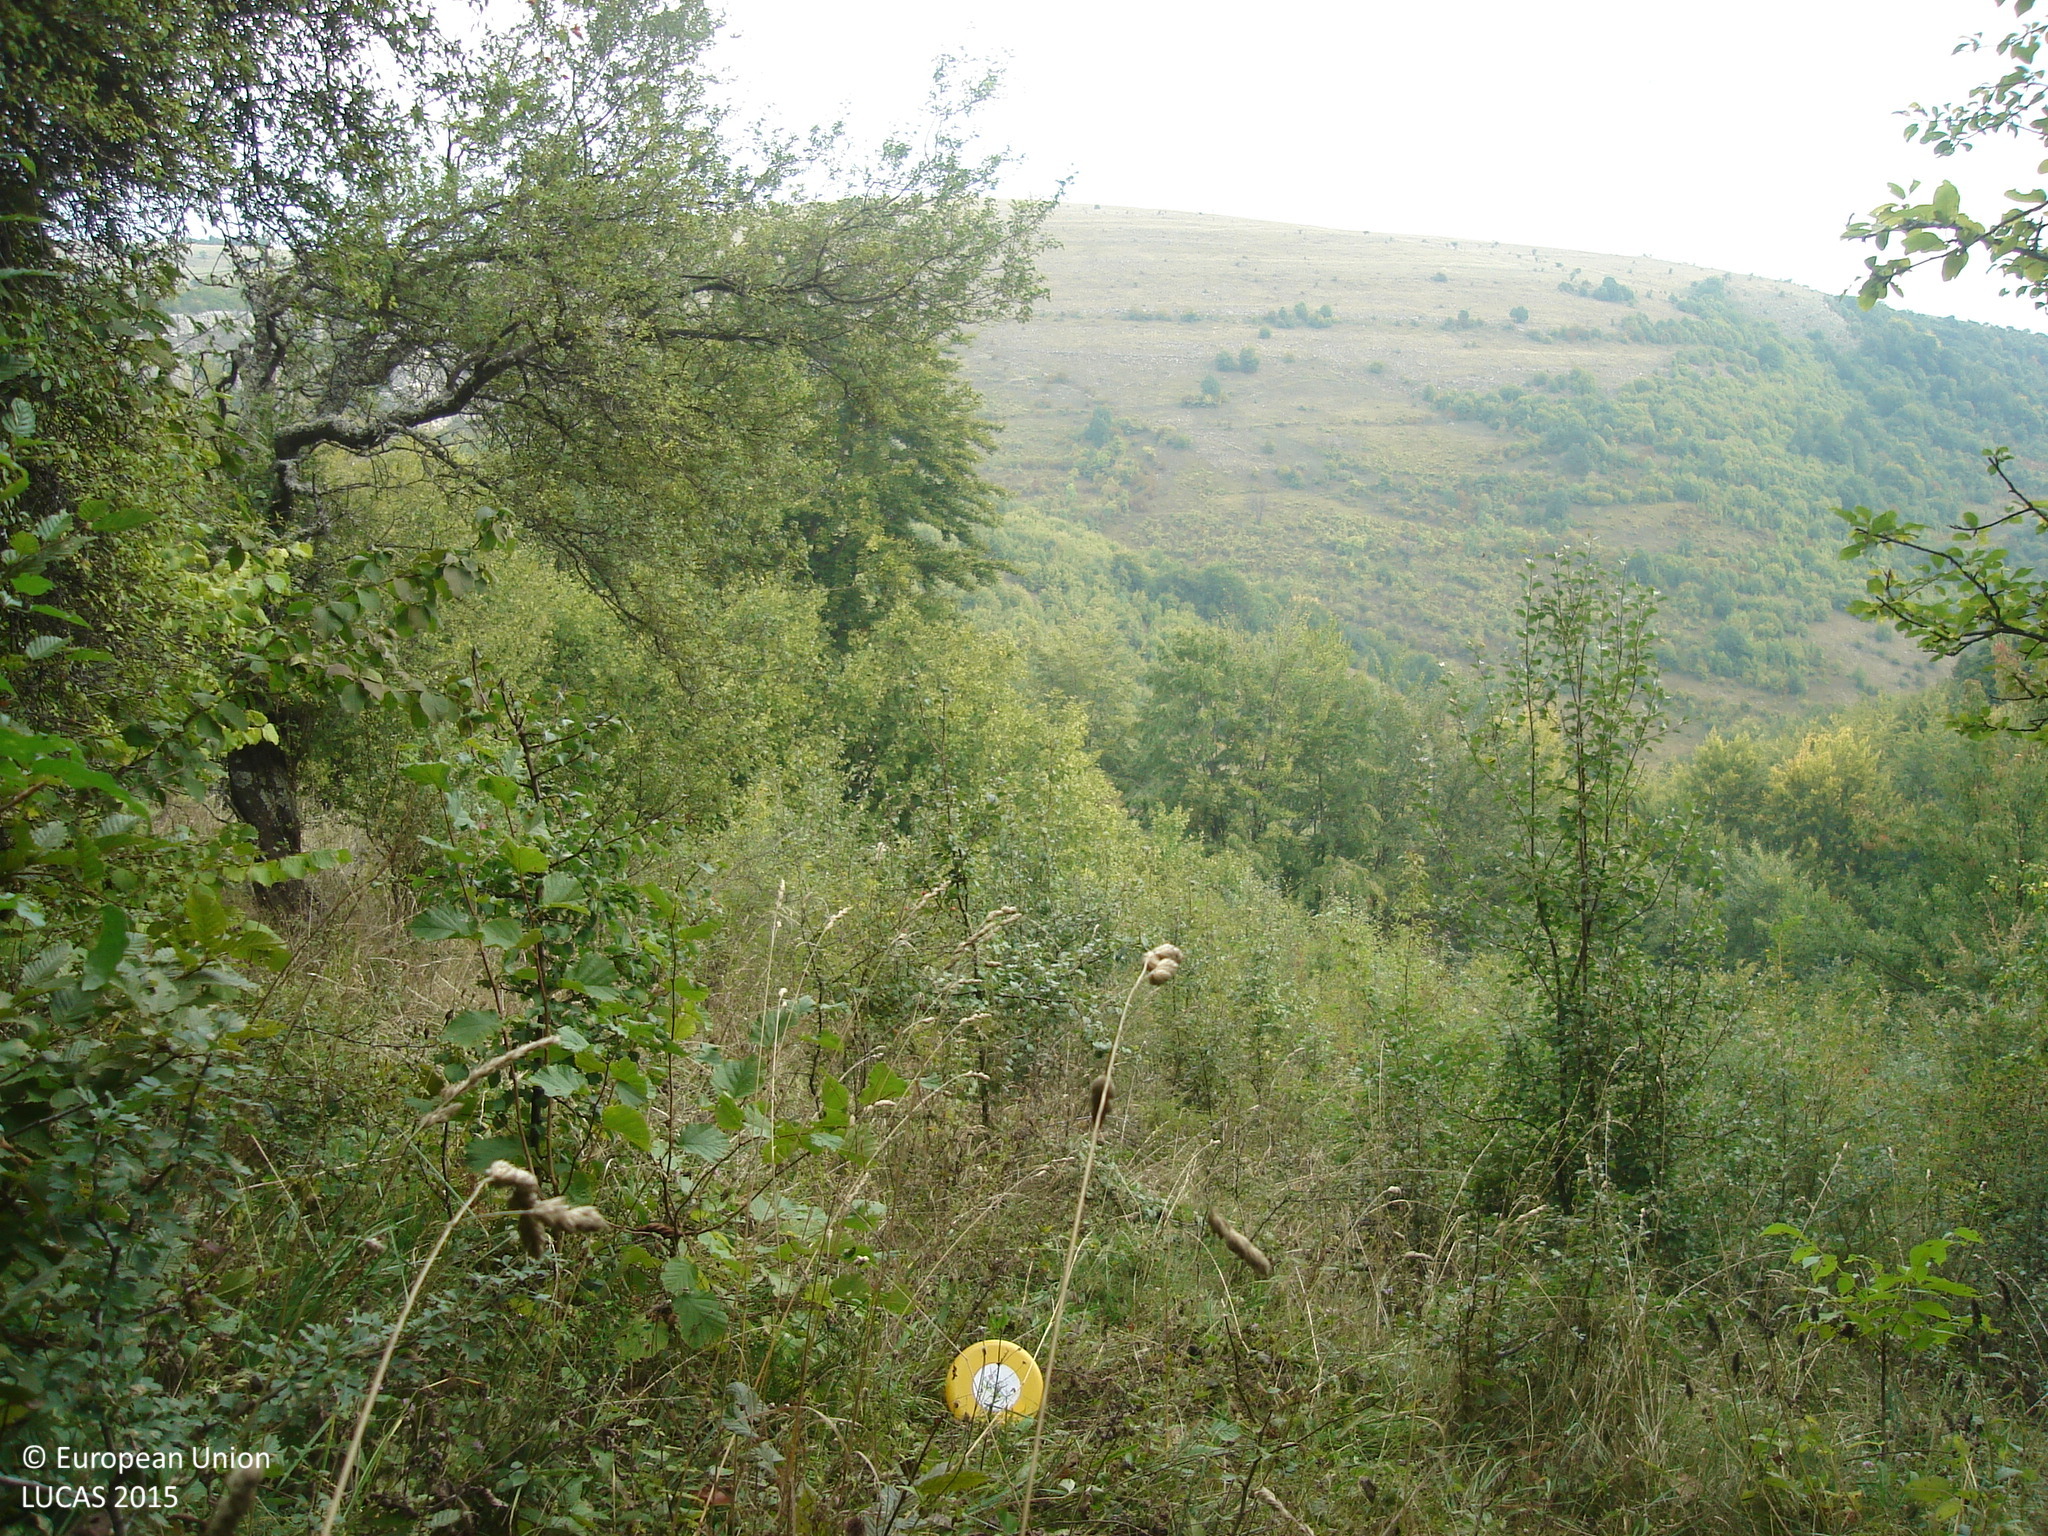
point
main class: Woodland
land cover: Broadleaved woodland
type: mesophytic deciduous forest
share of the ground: 50 - 75 %
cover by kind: broadleaved forest trees 60 %, shrubs 20 %, herbaceous plants 20 %
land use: Semi-natural and natural areas not in use
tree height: > 5 m
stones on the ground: < 10 %
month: October
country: BG
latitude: 43.0506
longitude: 23.3087
